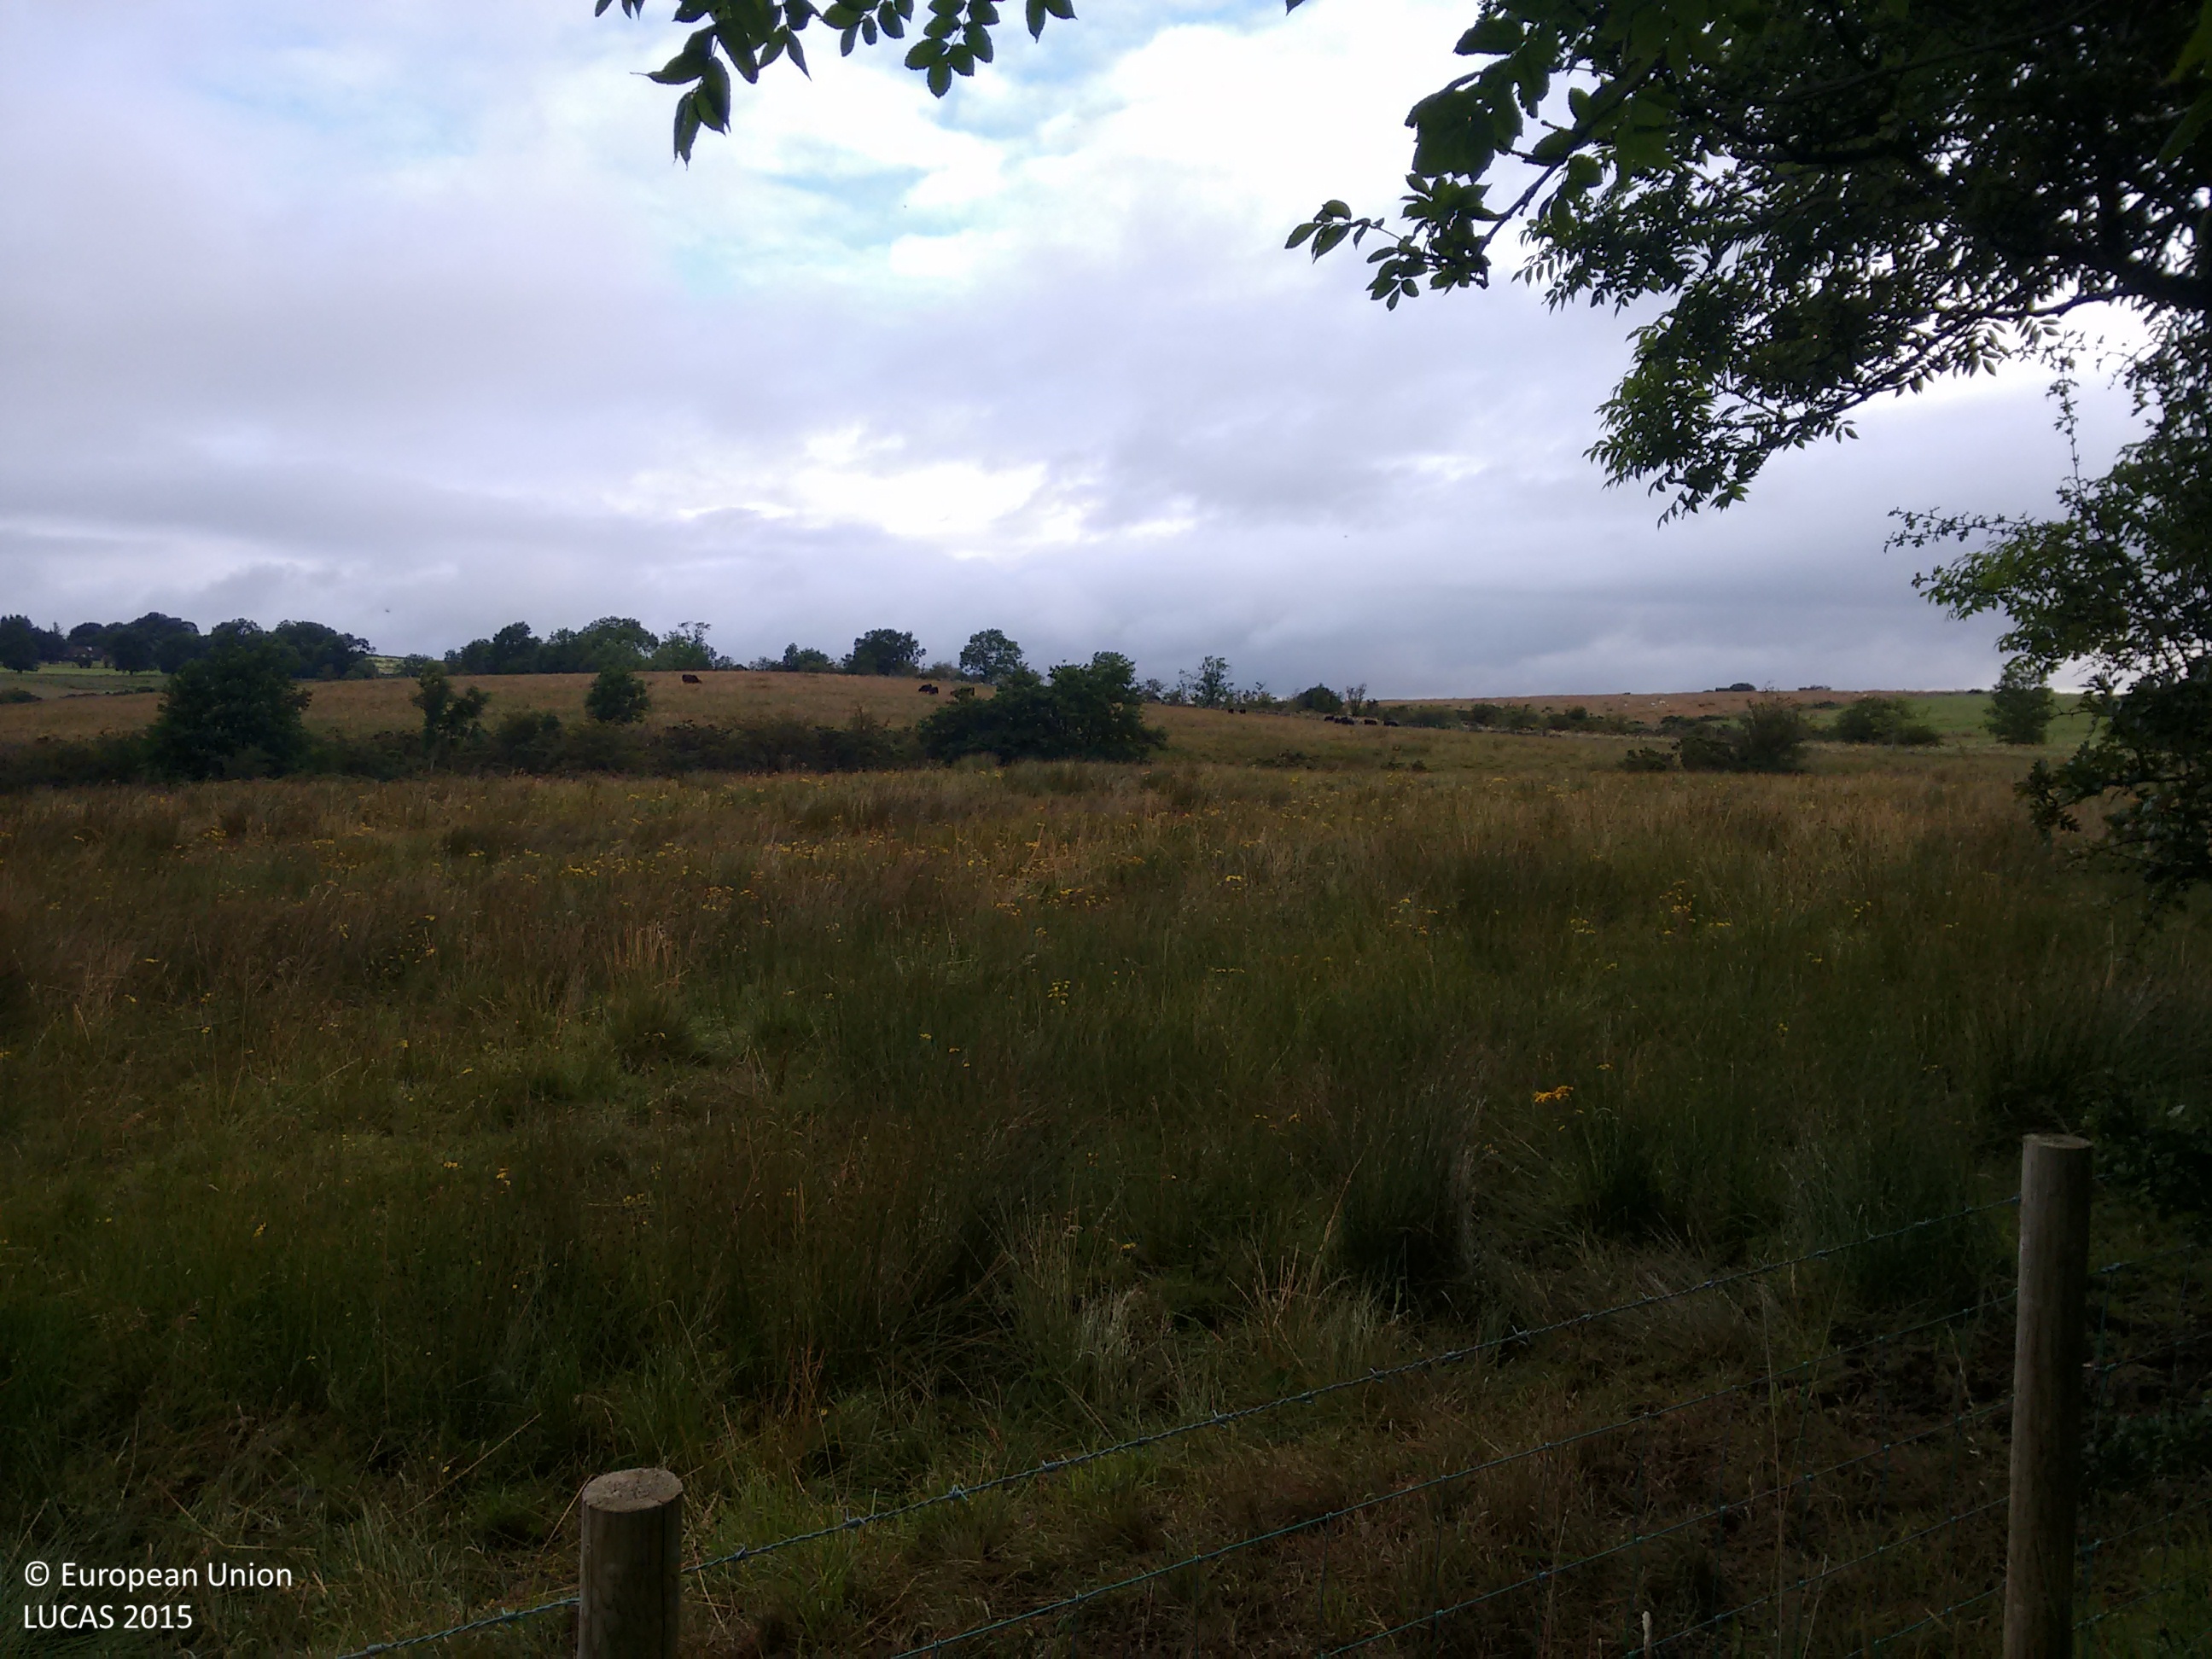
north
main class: Grassland
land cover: Grassland with sparse tree/shrub cover
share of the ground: > 75 %
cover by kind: herbaceous plants 95 %, broadleaved forest trees 5 %
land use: Agriculture (excluding fallow land and kitchen gardens)
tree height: > 5 m
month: August
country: GB
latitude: 54.7088
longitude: -2.9375
